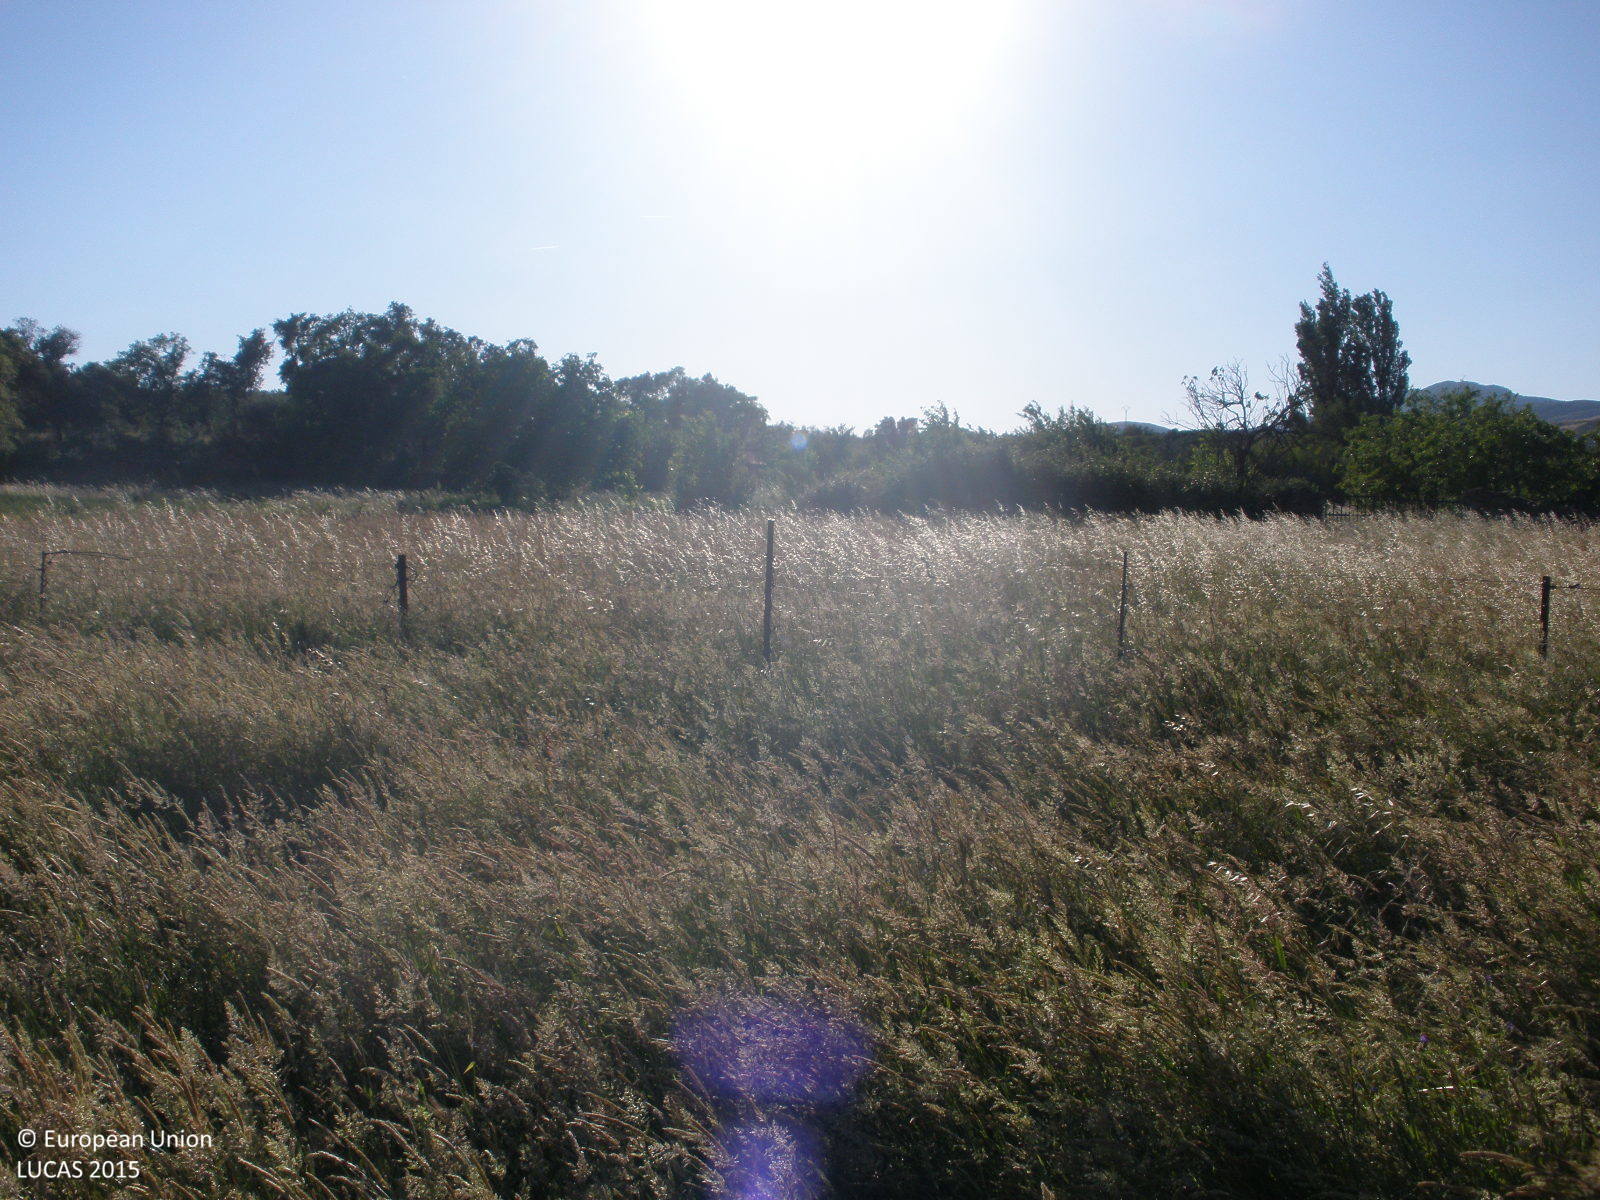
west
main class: Grassland
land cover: Spontaneously vegetated surfaces
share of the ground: > 75 %
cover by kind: herbaceous plants 100 %
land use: Fallow land
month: May
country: ES
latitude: 40.2337
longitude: -6.2147
